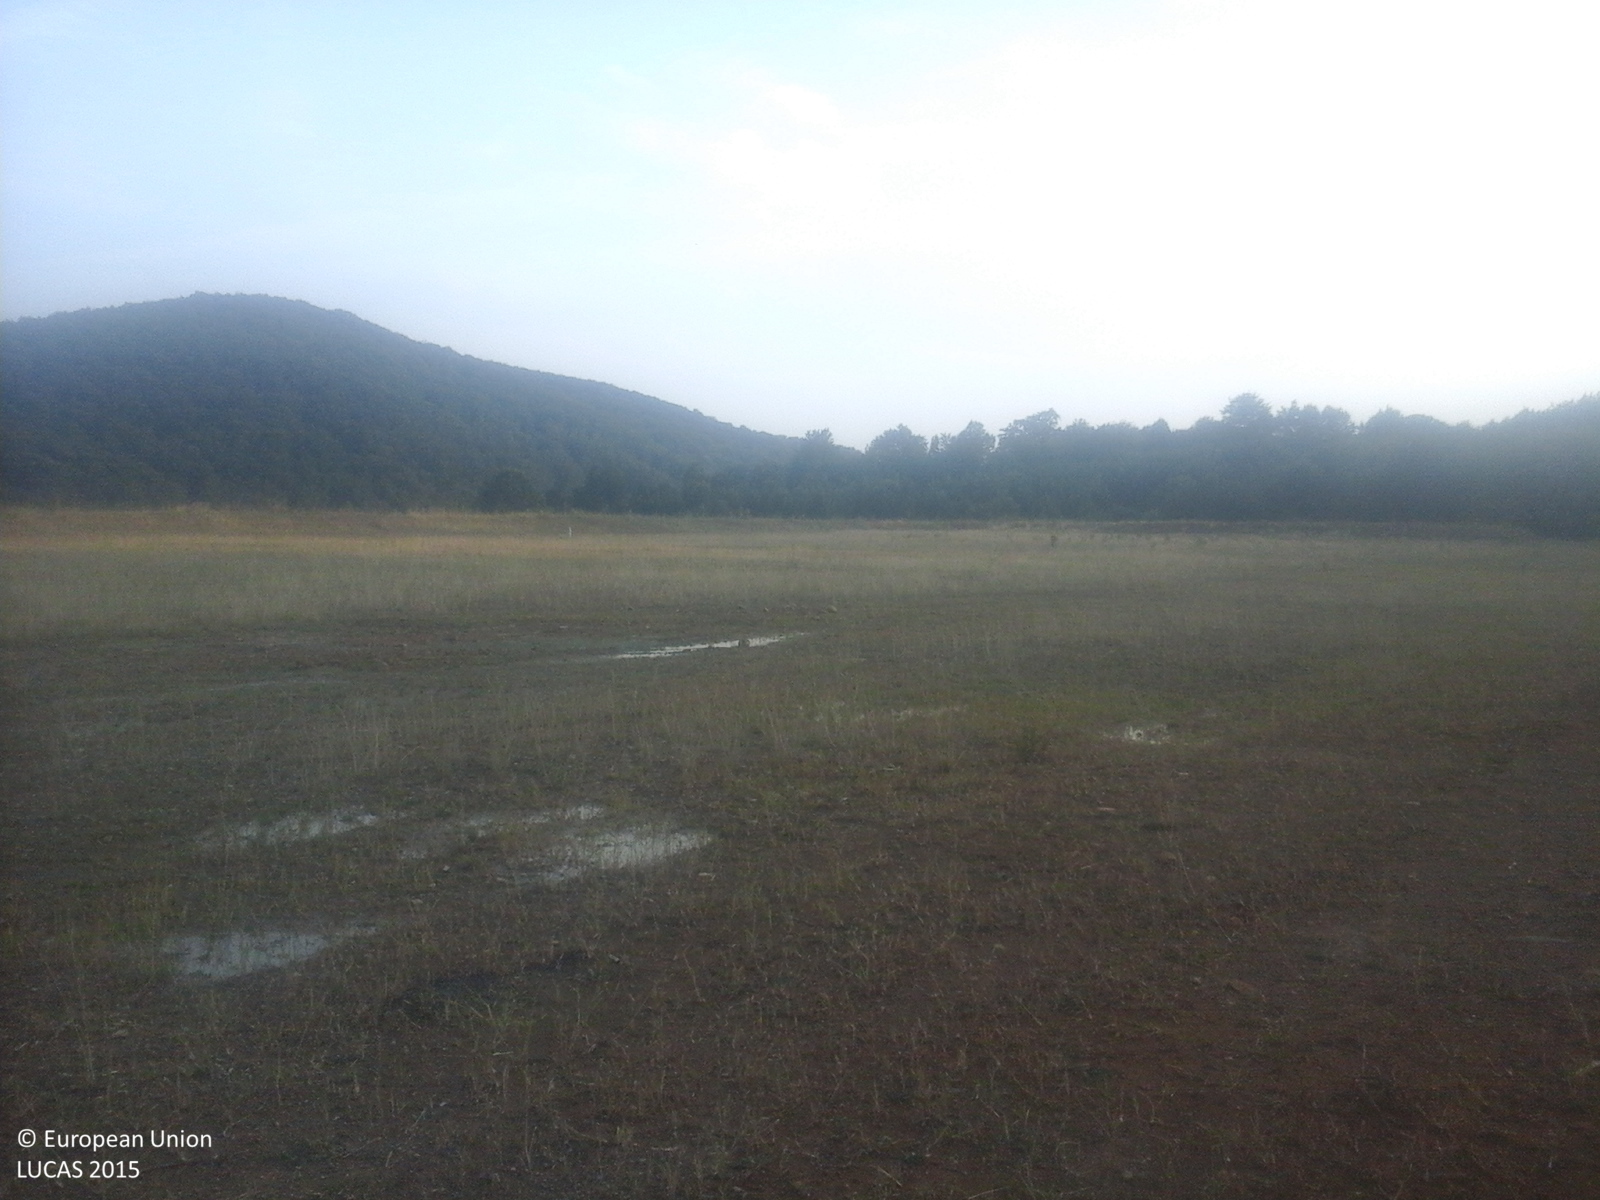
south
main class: Grassland
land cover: Grassland without tree/shrub cover
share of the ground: 50 - 75 %
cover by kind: herbaceous plants 100 %
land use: Agriculture (excluding fallow land and kitchen gardens)
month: September
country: RO
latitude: 47.6243
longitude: 23.7992
